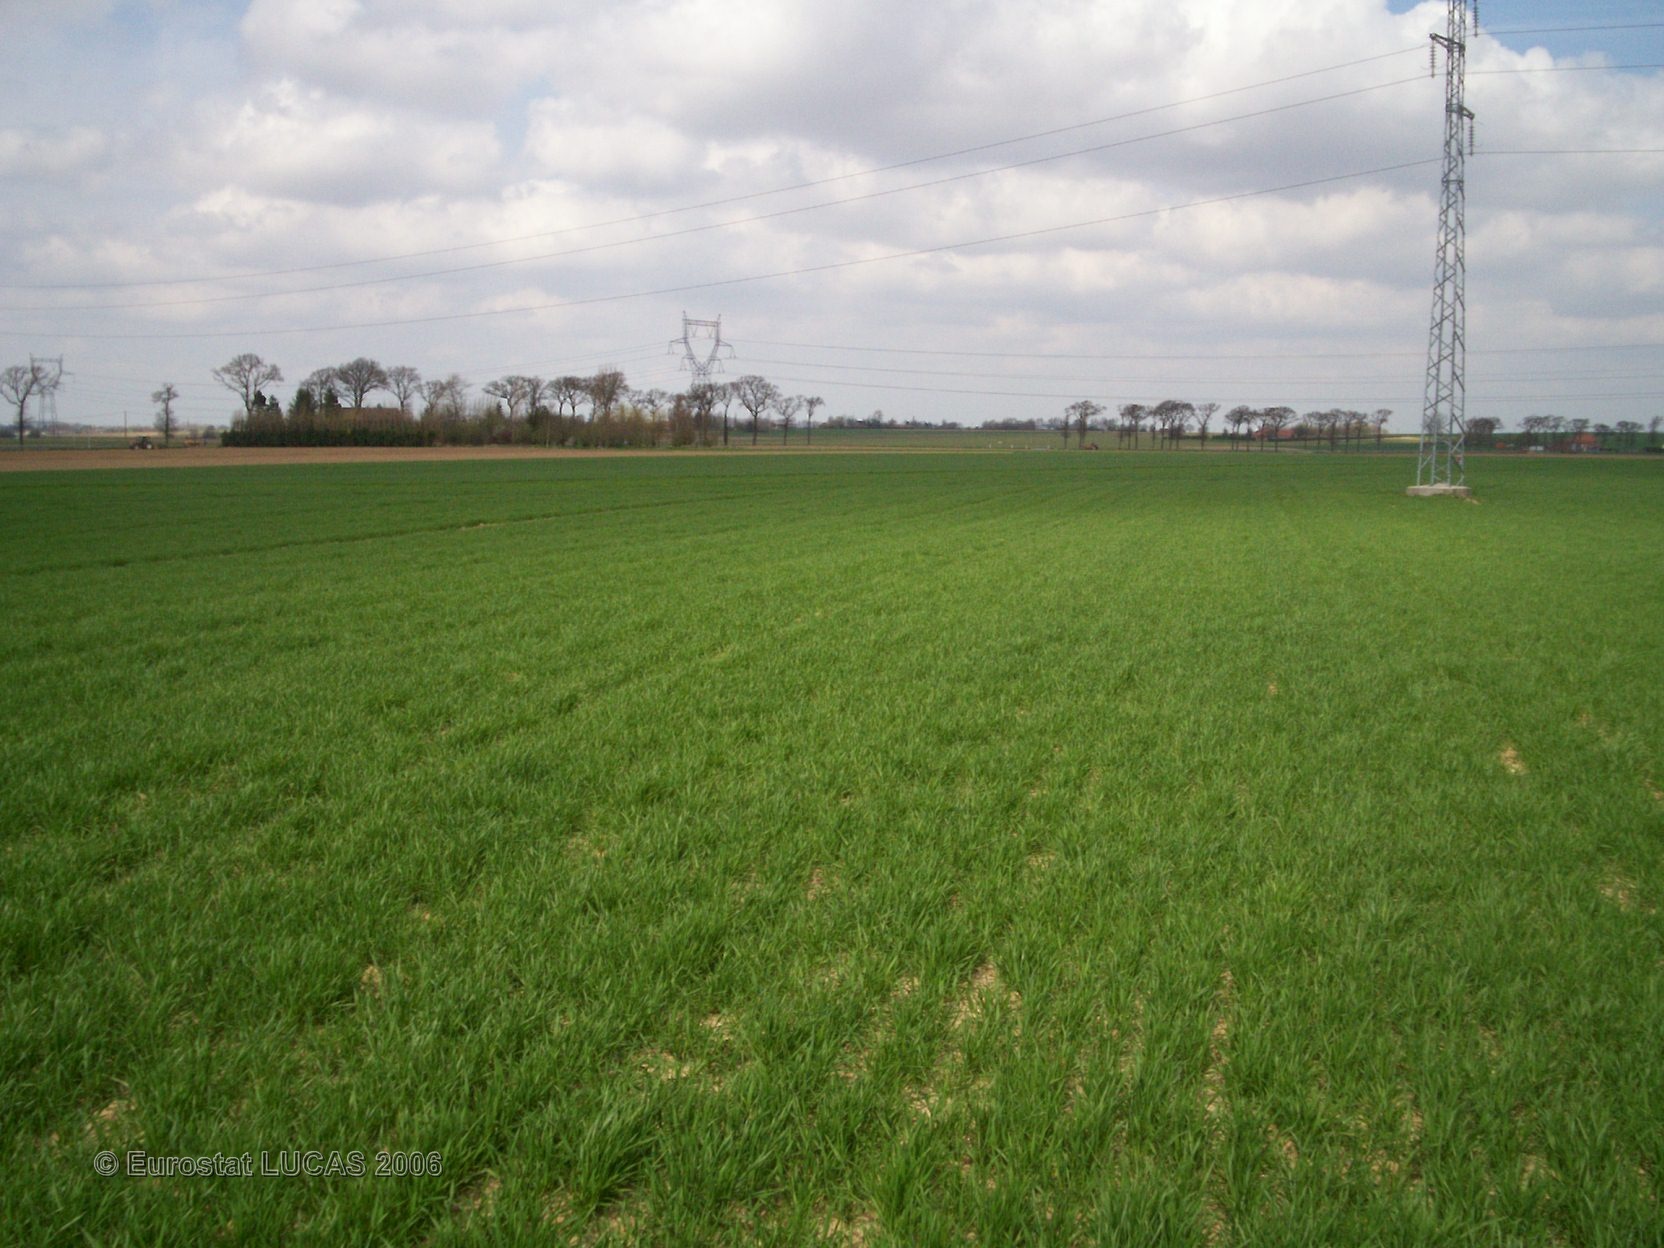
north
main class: Cropland
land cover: Common wheat
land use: Agriculture (excluding fallow land and kitchen gardens)
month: April
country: FR
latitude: 50.7632
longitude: 2.4302
